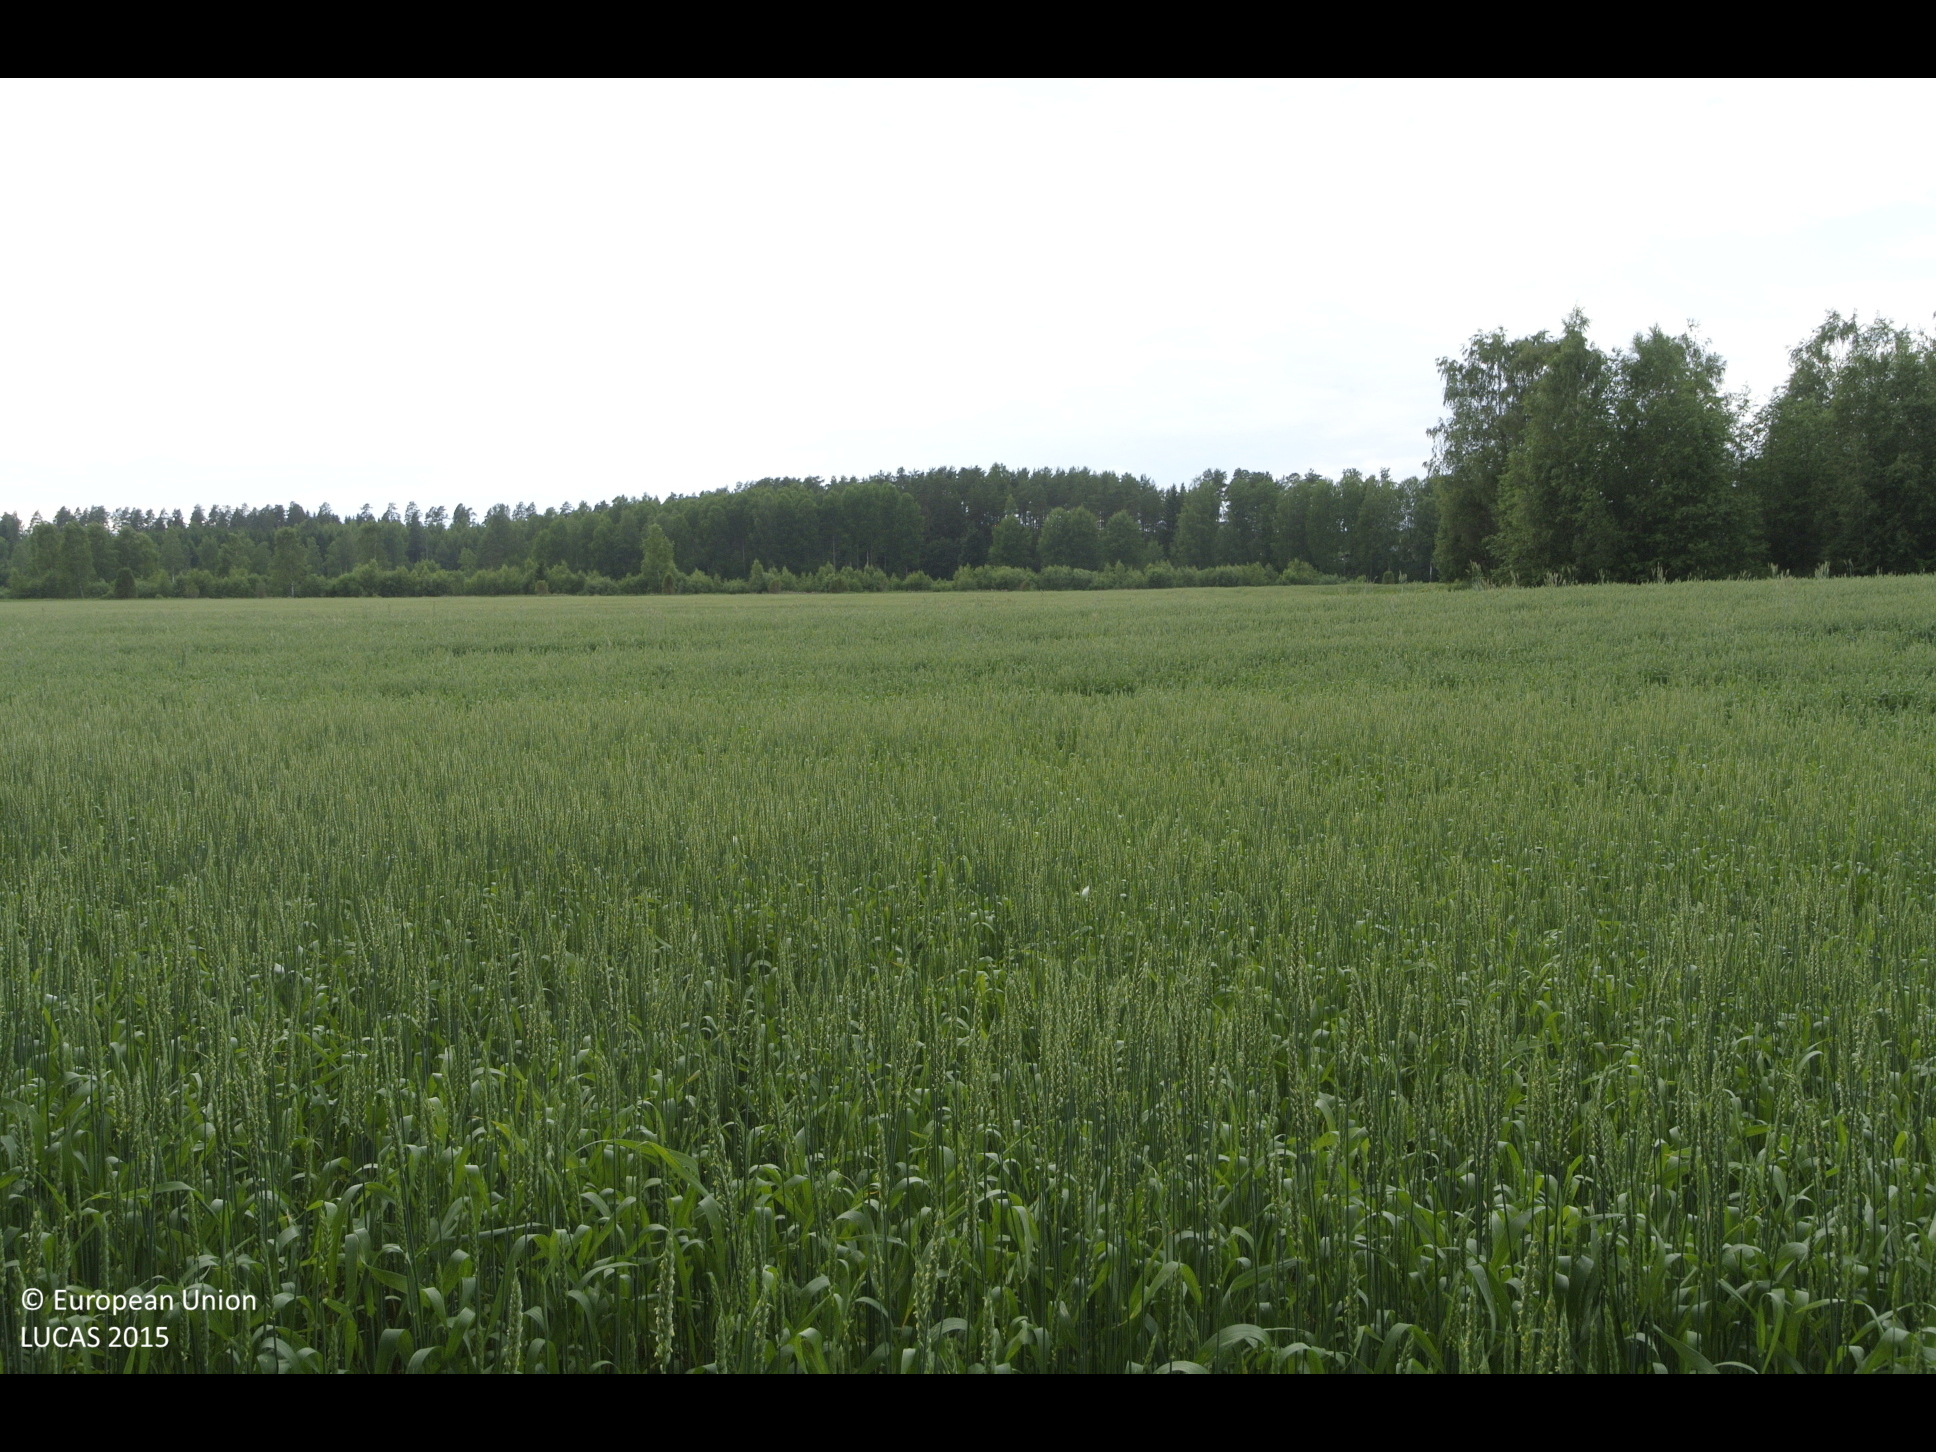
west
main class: Cropland
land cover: Common wheat
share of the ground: > 75 %
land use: Agriculture (excluding fallow land and kitchen gardens)
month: July
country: FI
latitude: 61.3170
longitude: 25.7237
